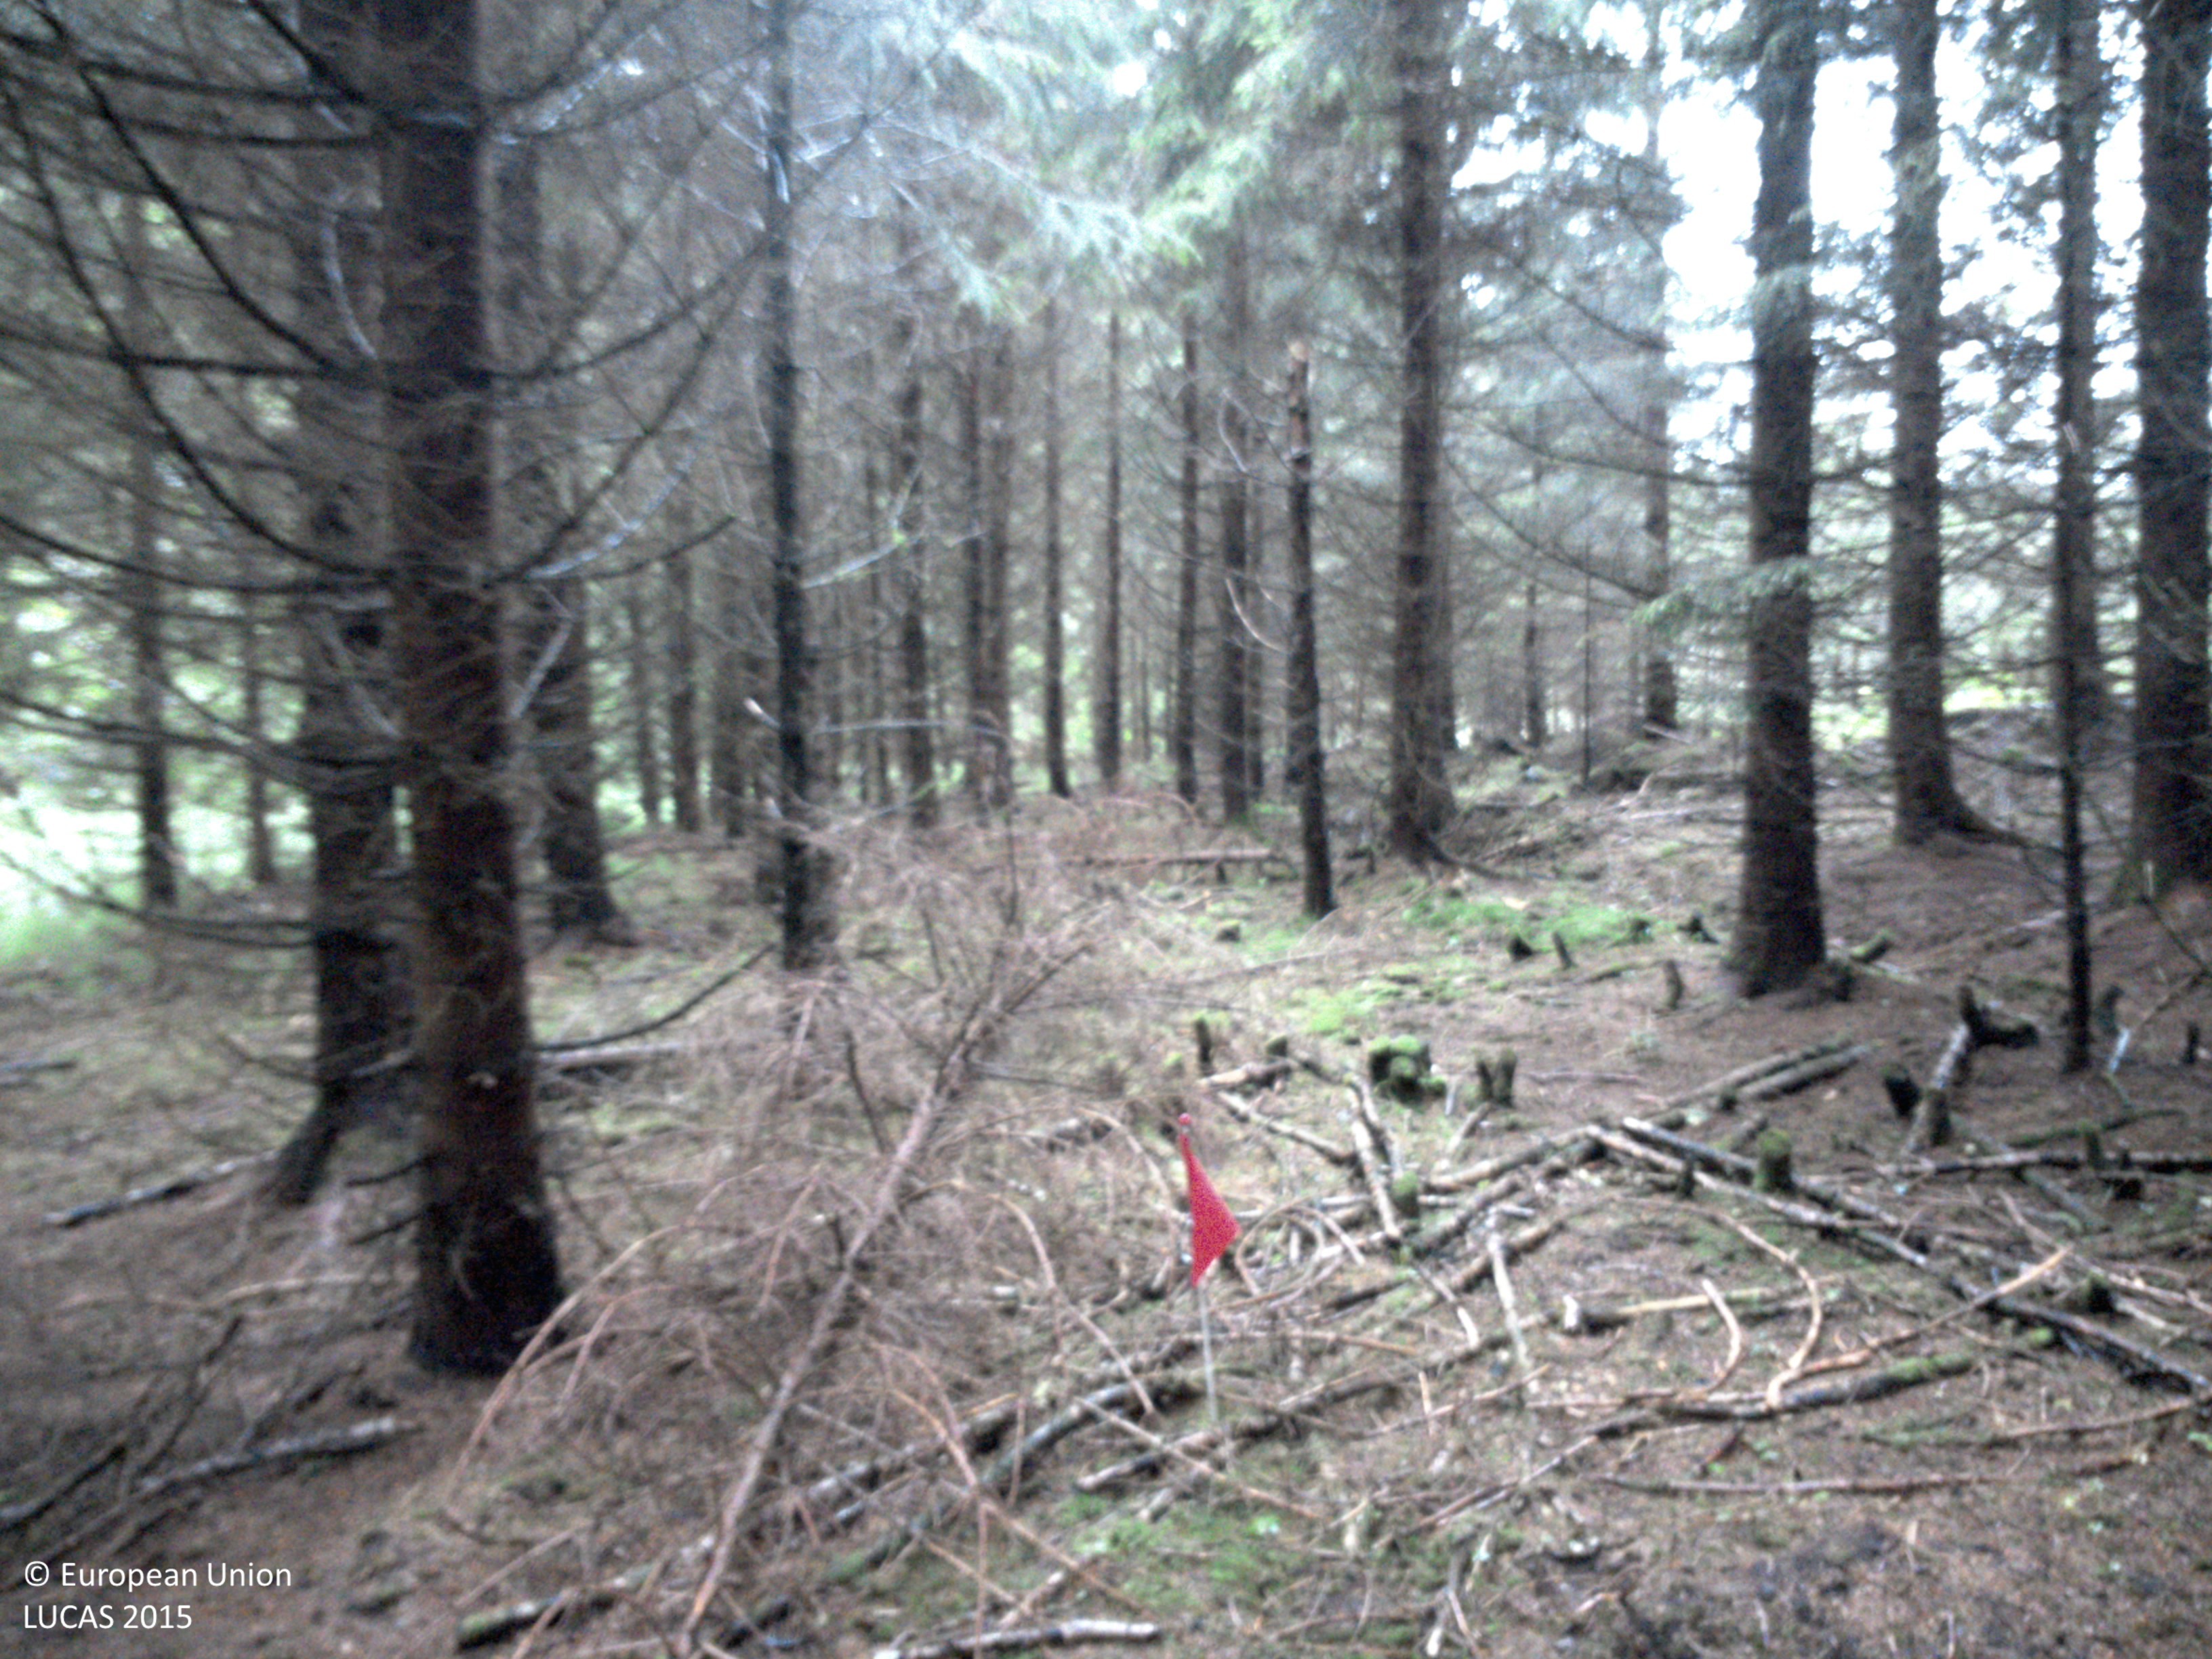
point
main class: Woodland
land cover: Spruce dominated coniferous woodland
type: boreal forest
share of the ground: > 75 %
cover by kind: coniferous forest trees 80 %, lichens and mosses 20 %
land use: Forestry
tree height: > 5 m
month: July
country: SE
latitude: 58.6902
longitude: 12.0142
